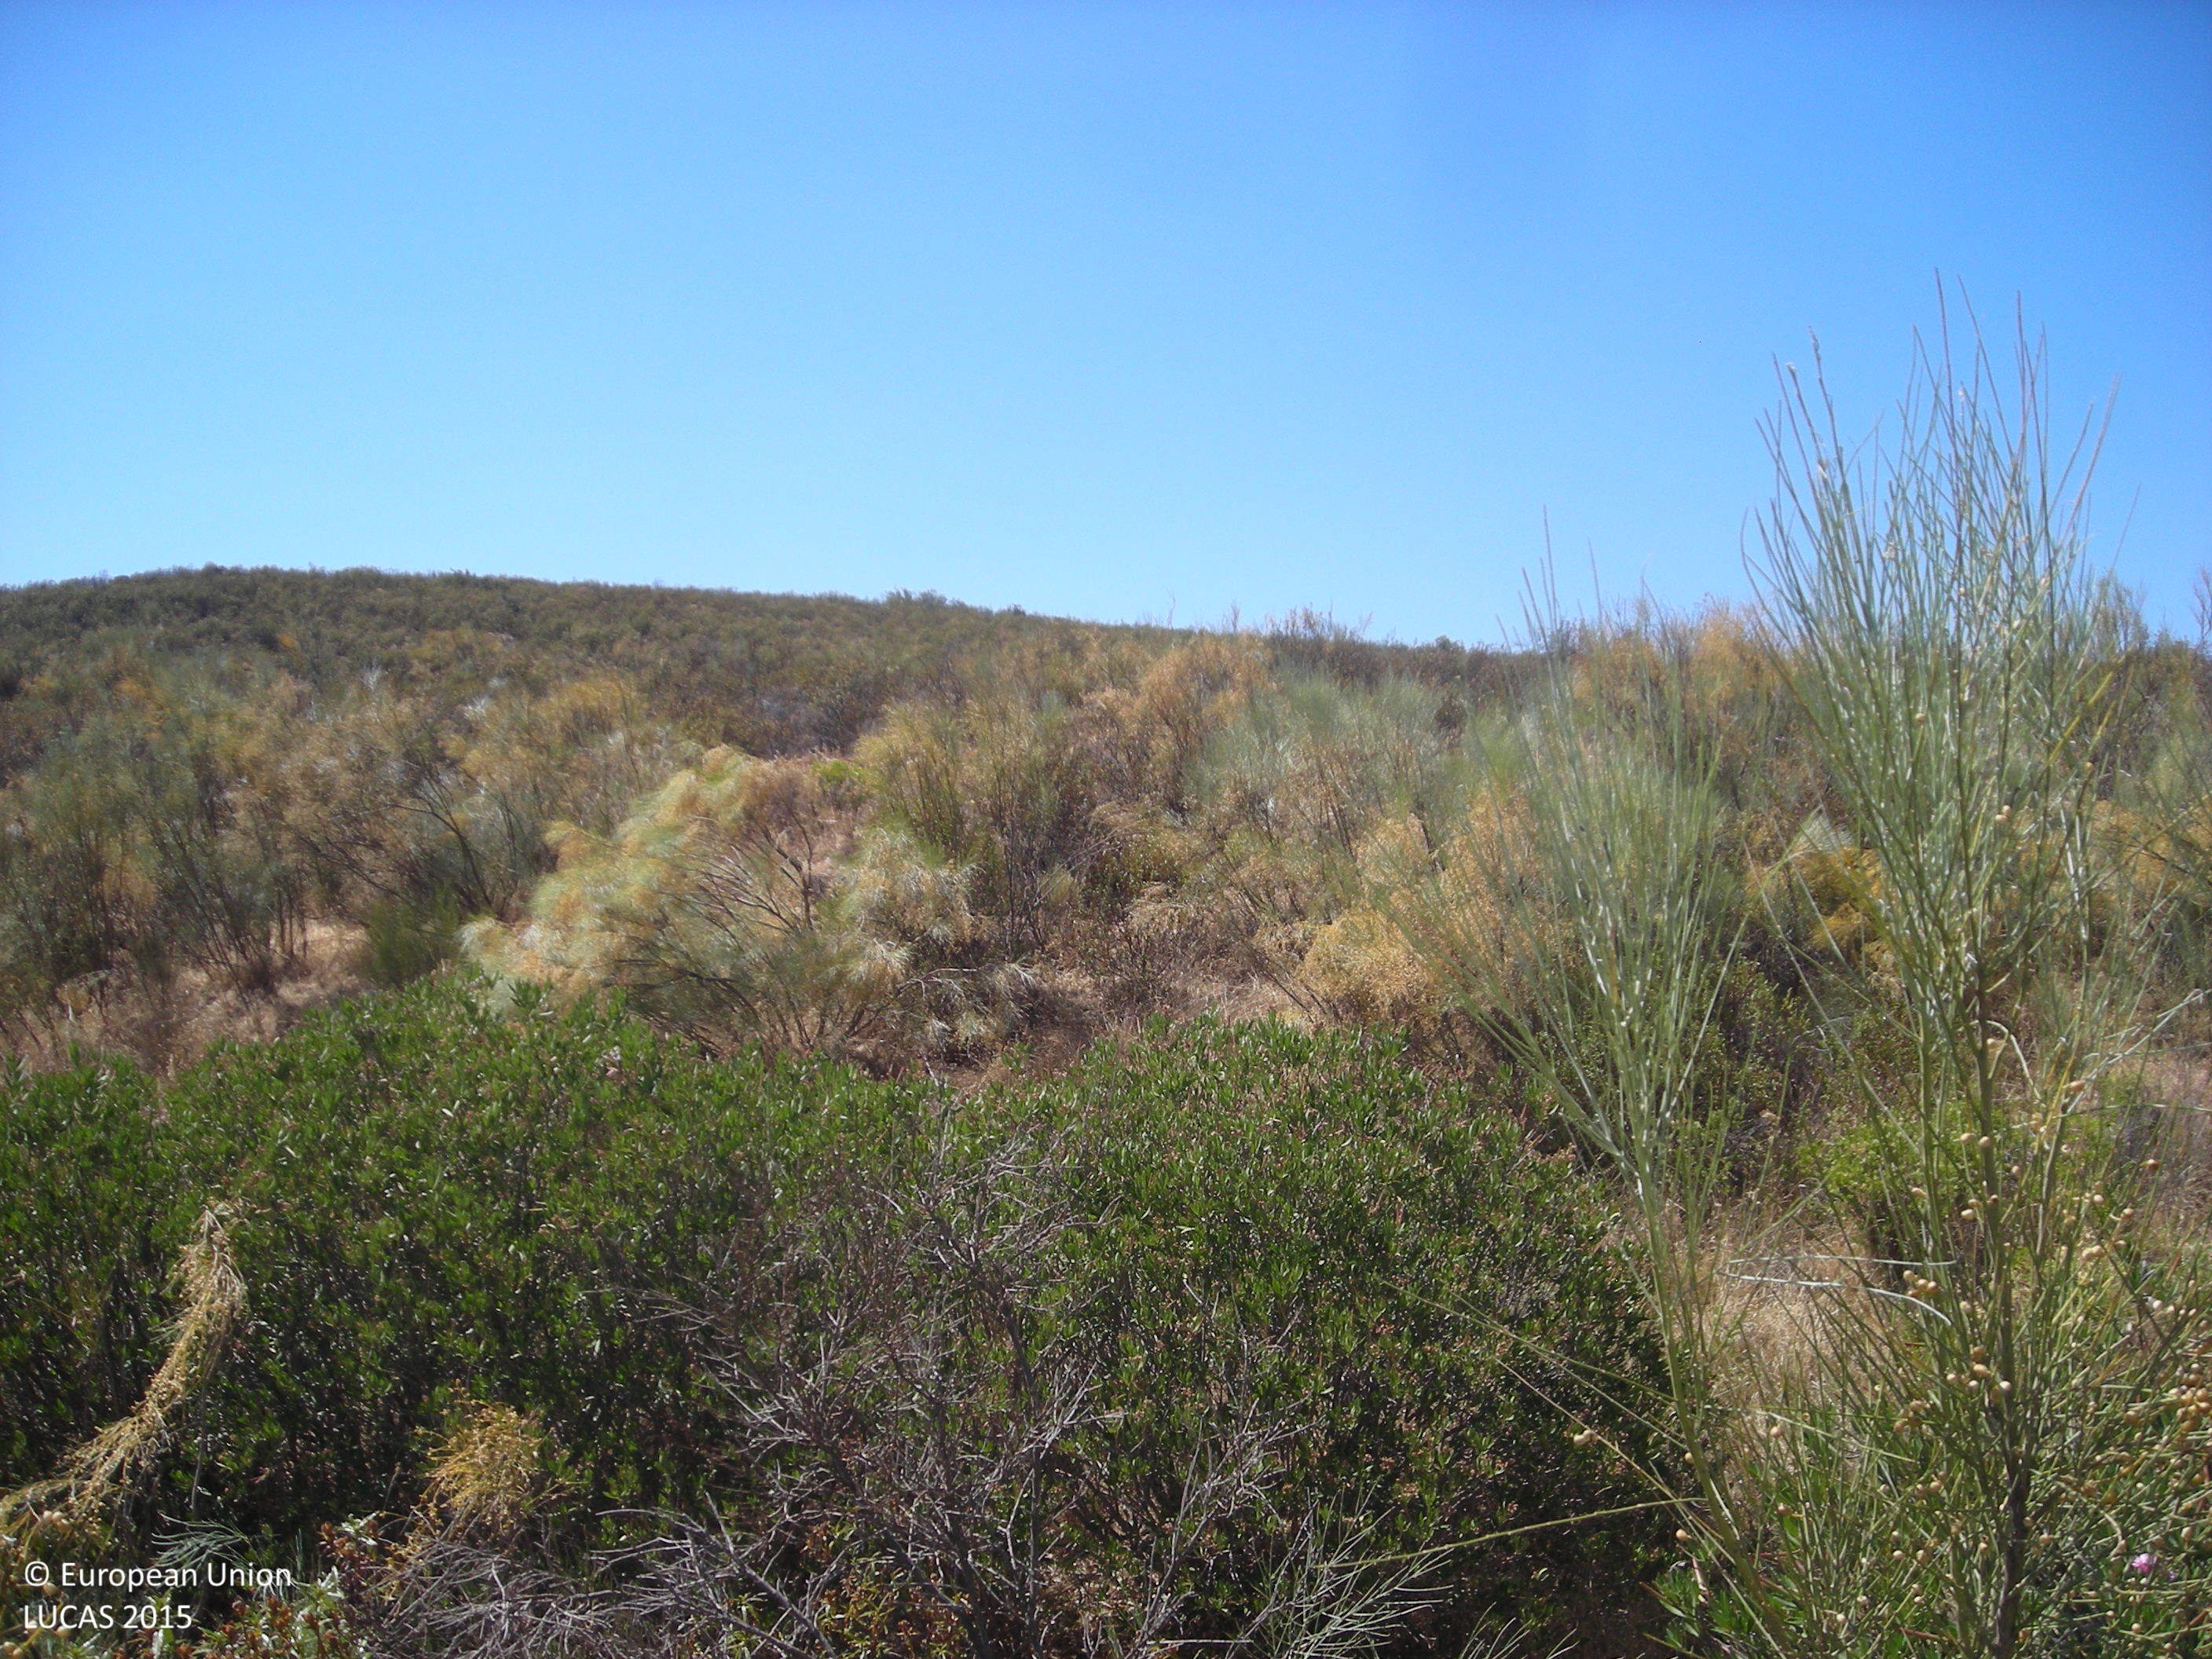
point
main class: Shrubland
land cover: Shrubland without tree cover
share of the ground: > 75 %
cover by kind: shrubs 100 %
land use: Semi-natural and natural areas not in use
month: July
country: ES
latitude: 38.7788
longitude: -5.7803
